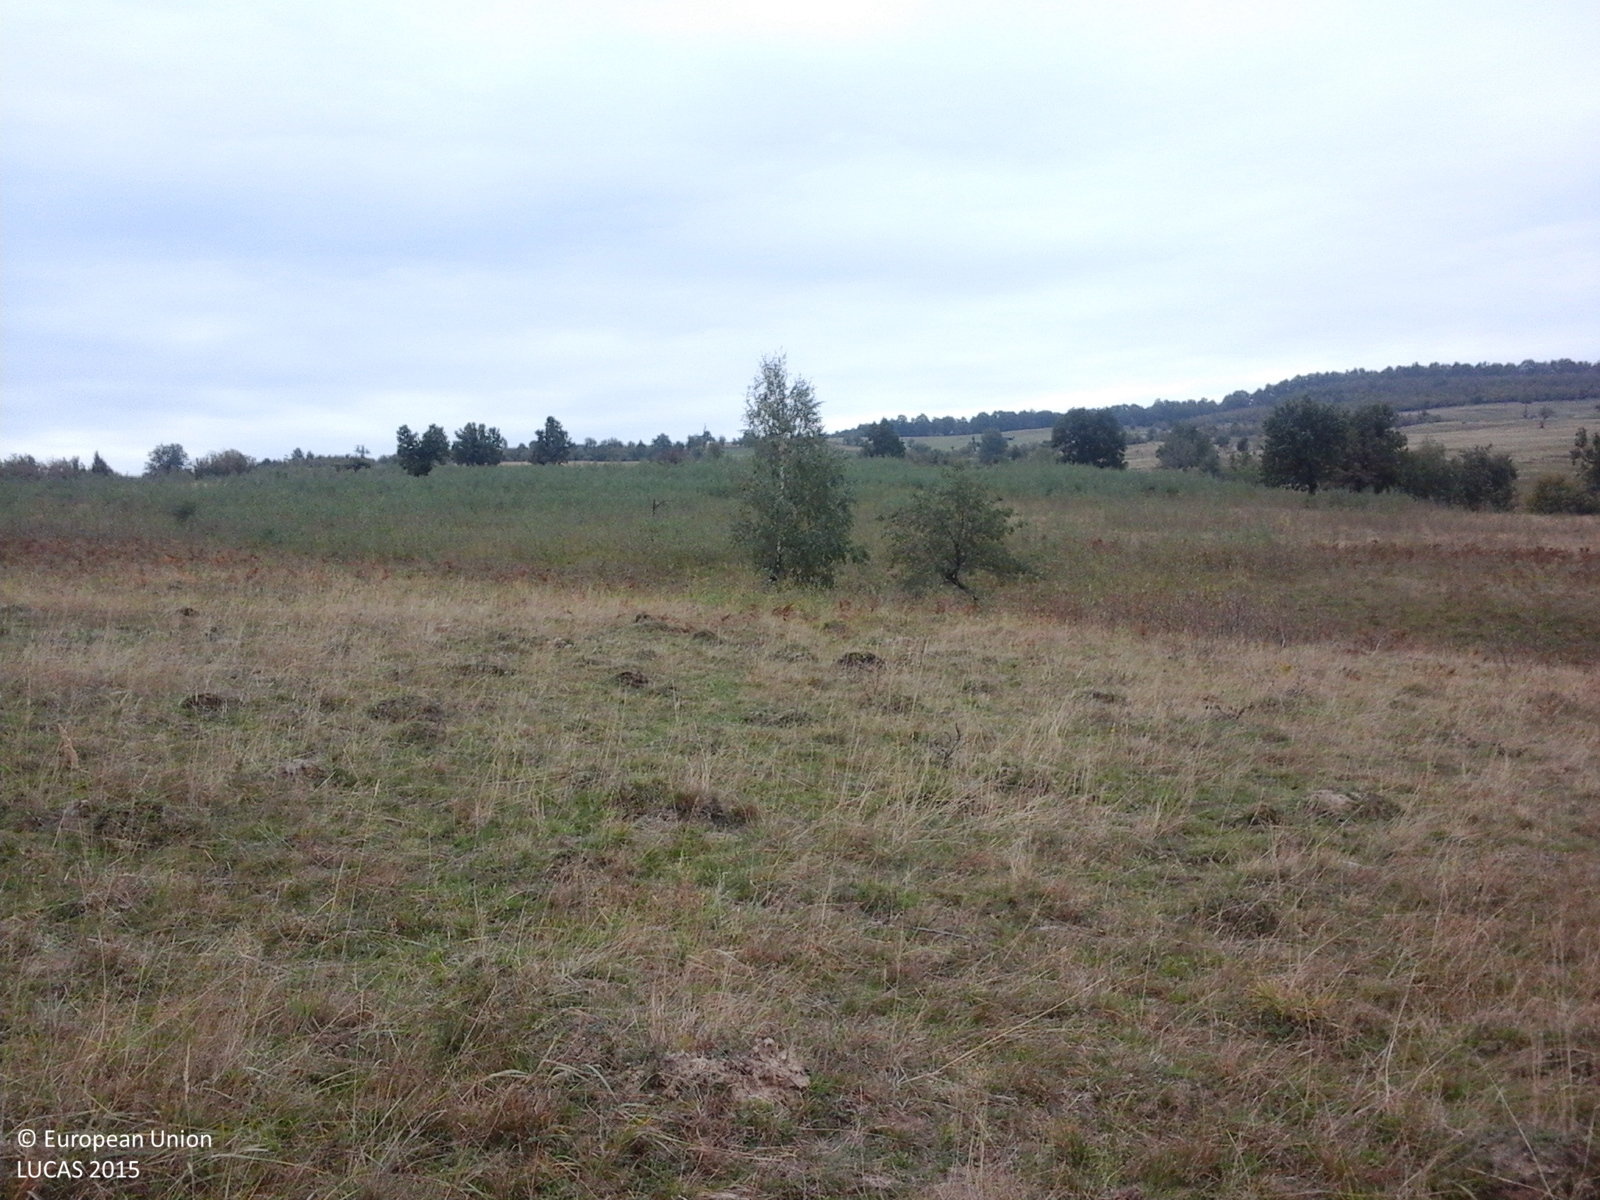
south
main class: Grassland
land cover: Grassland without tree/shrub cover
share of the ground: > 75 %
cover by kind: herbaceous plants 100 %
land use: Agriculture (excluding fallow land and kitchen gardens)
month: October
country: RO
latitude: 46.9115
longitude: 24.8950
